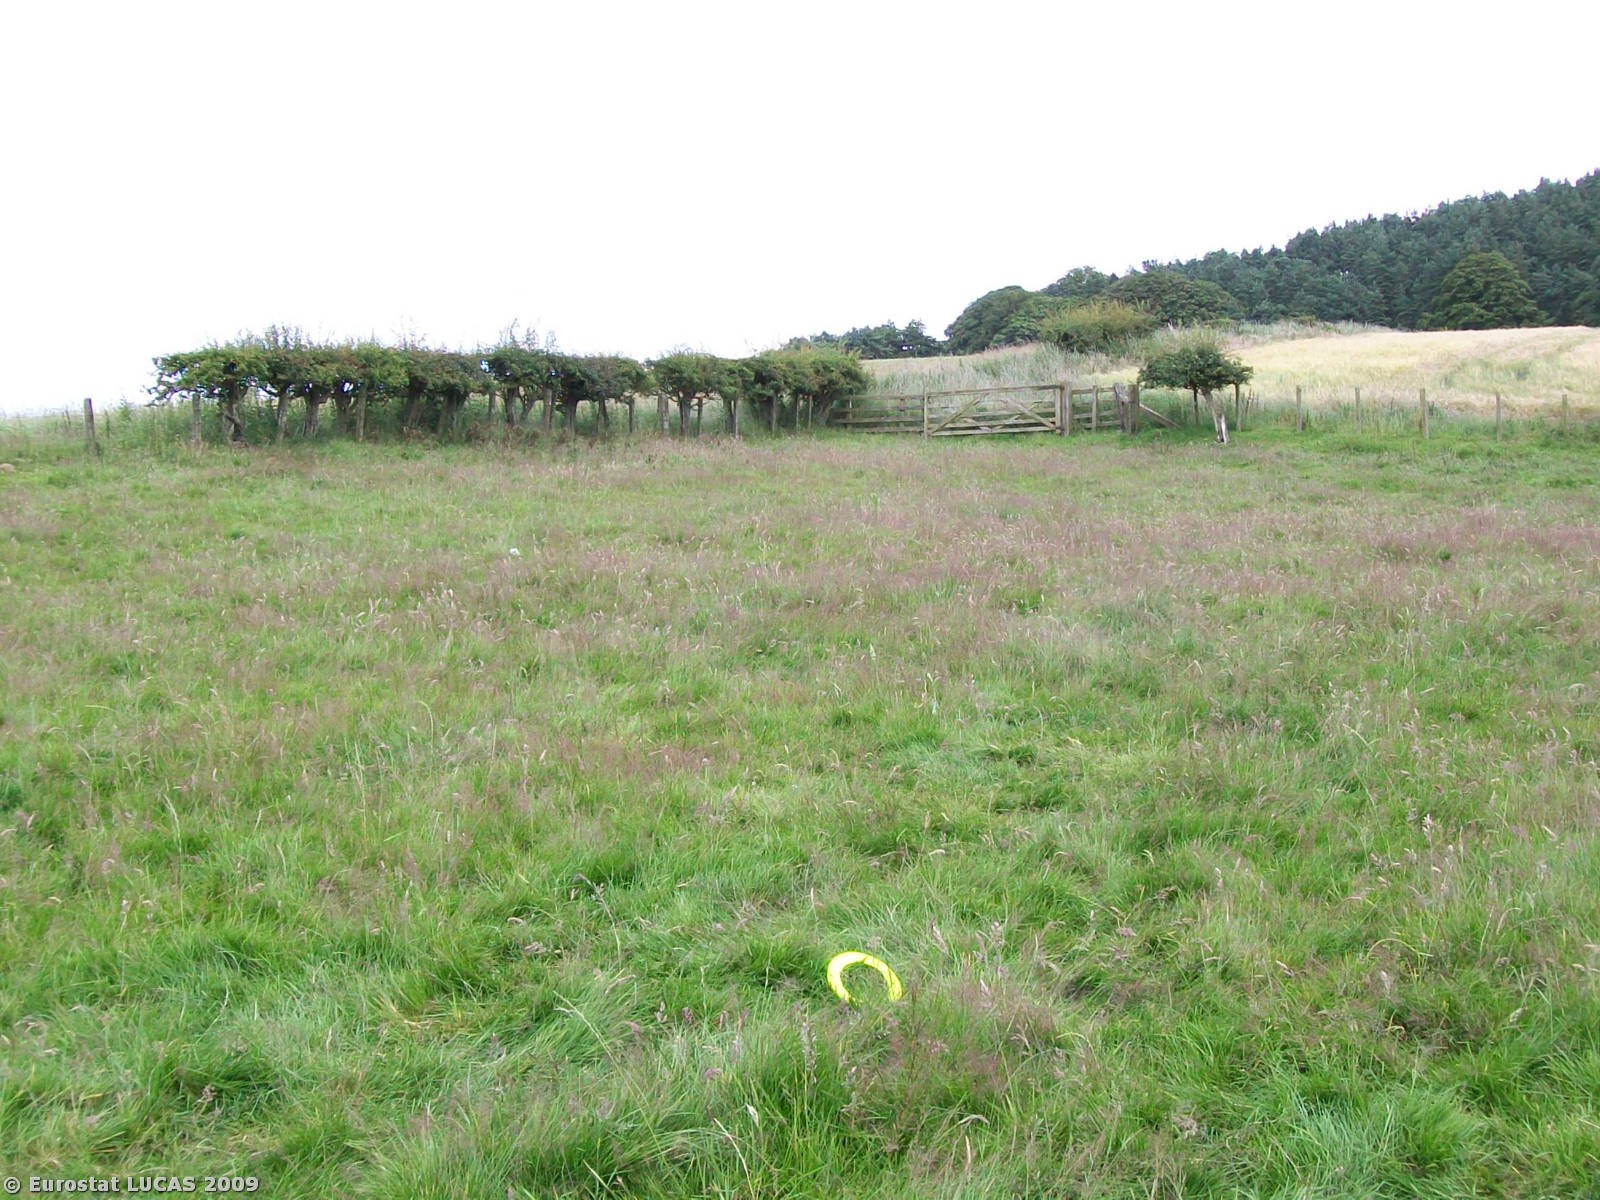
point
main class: Grassland
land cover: Grassland without tree/shrub cover
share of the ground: > 75 %
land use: Agriculture (excluding fallow land and kitchen gardens)
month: July
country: GB
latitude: 55.4533
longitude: -1.8627
